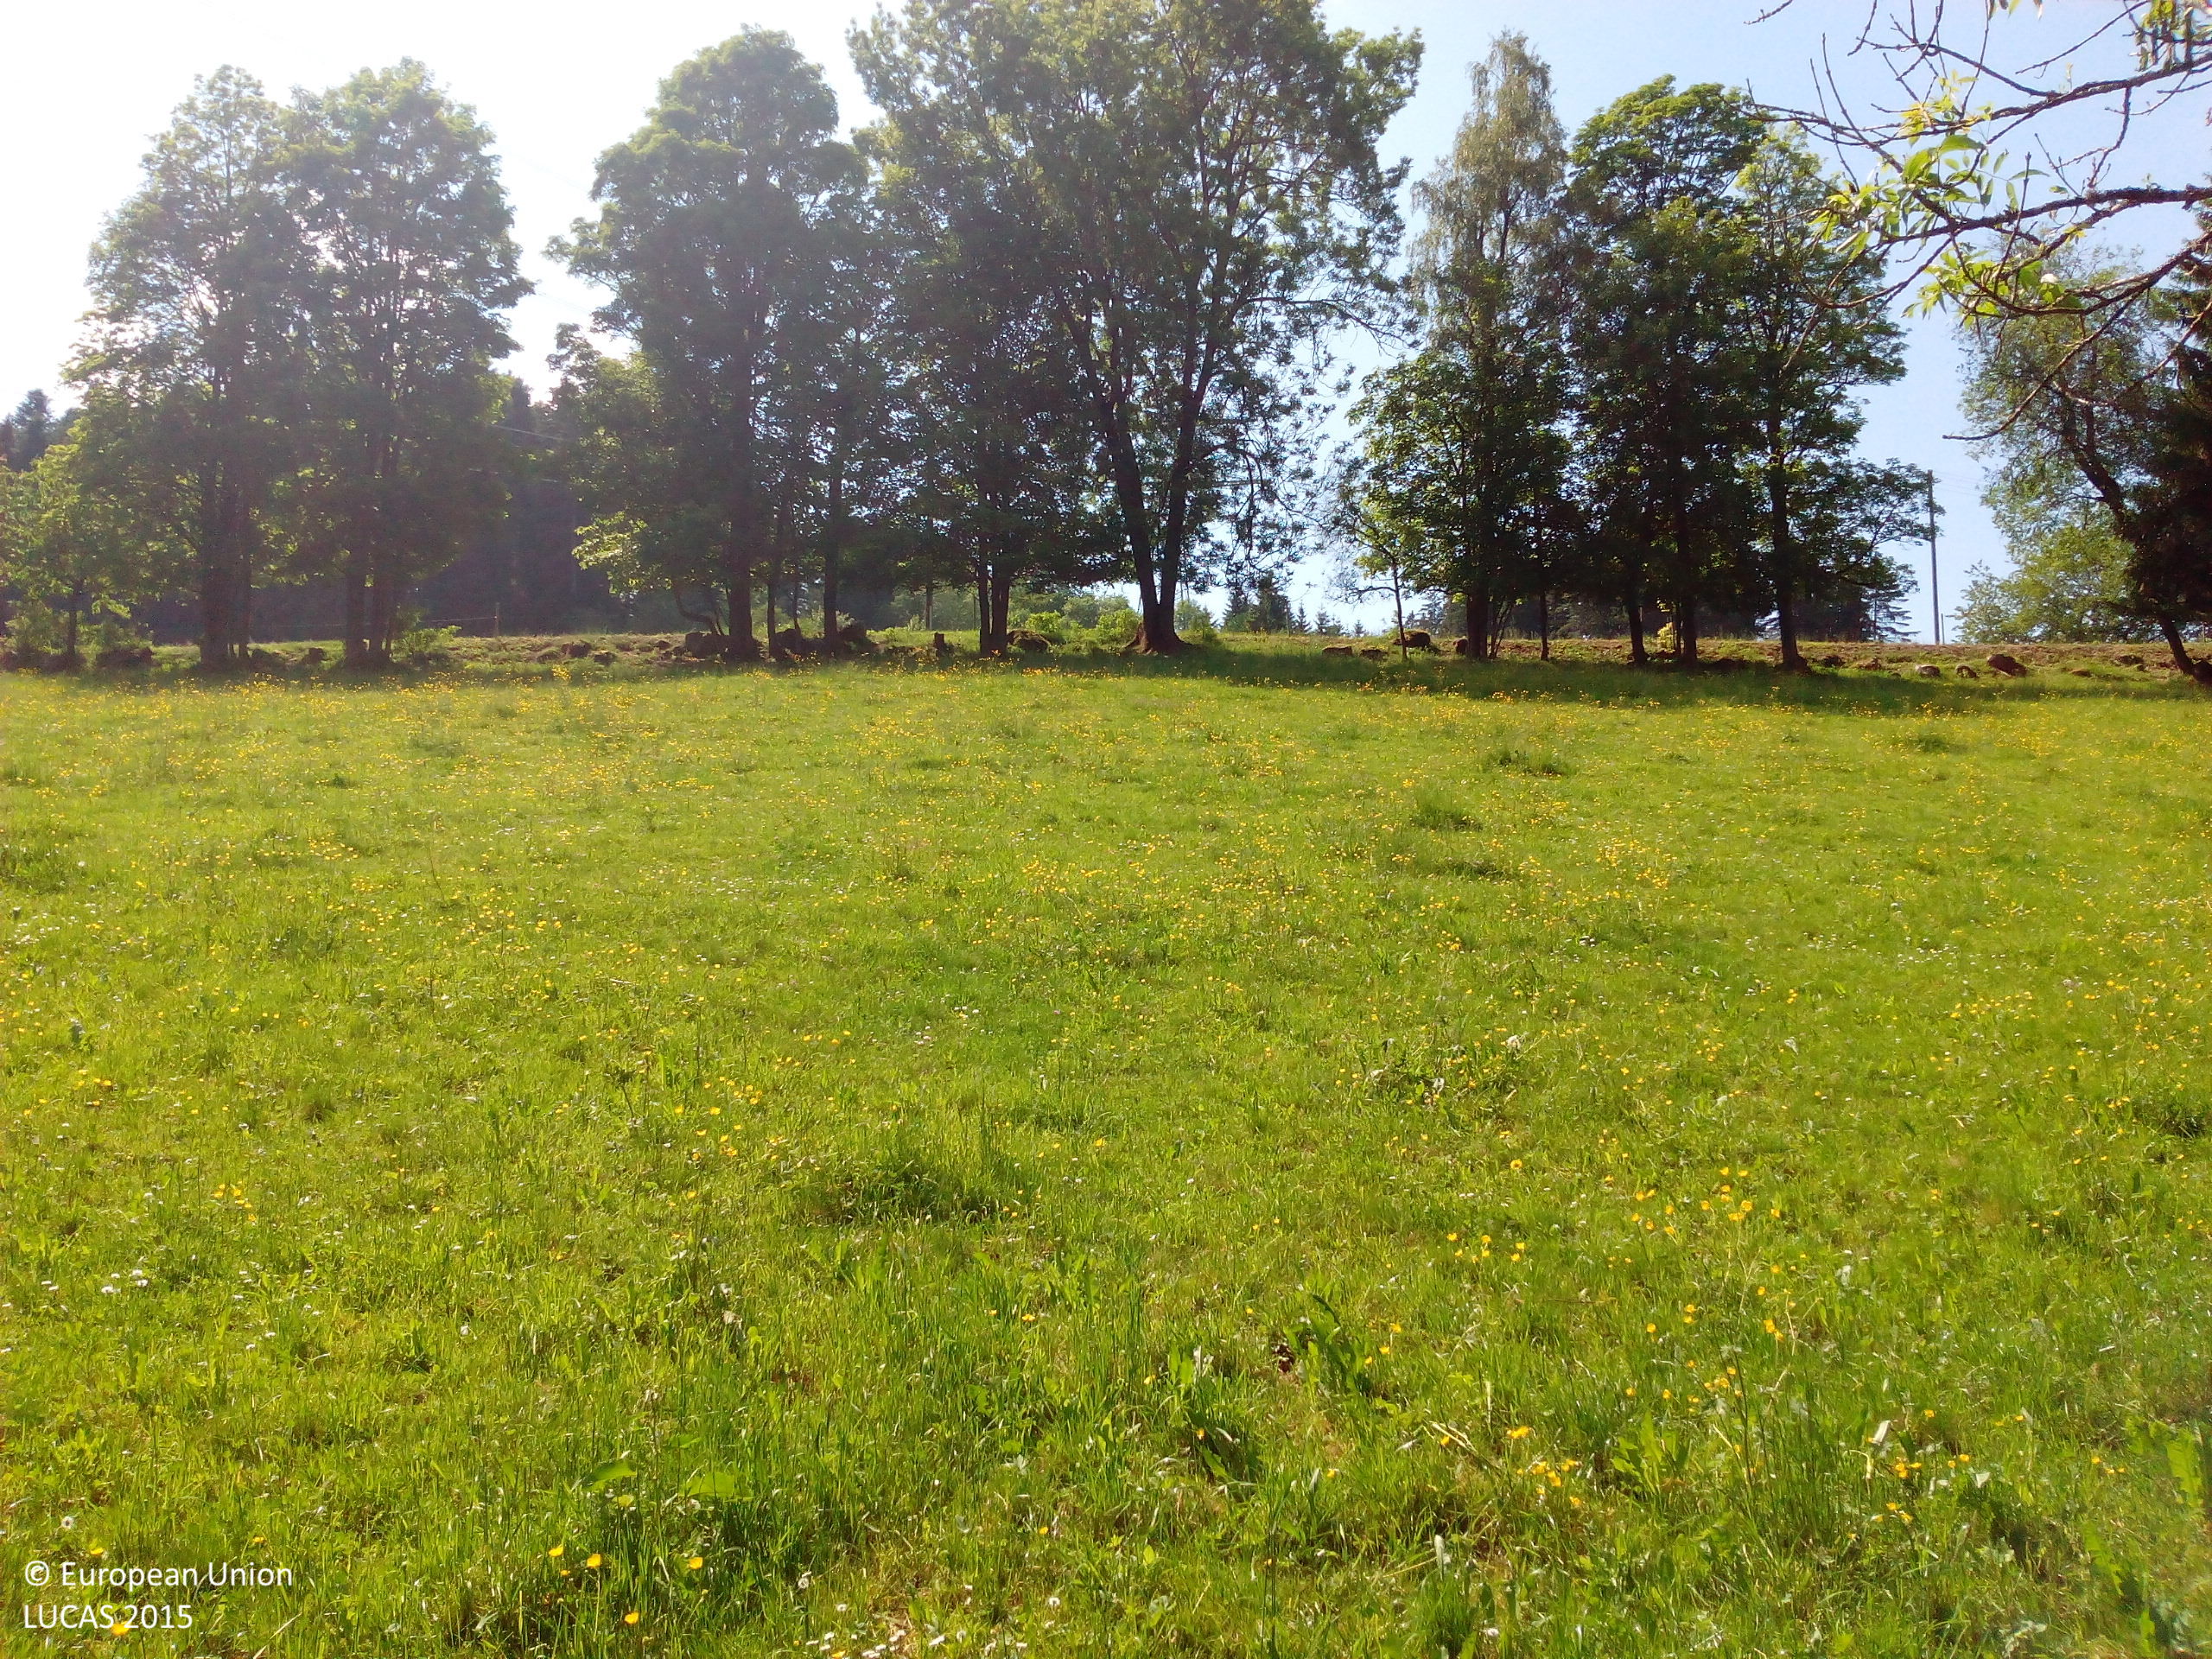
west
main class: Woodland
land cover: Broadleaved woodland
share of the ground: > 75 %
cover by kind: broadleaved forest trees 80 %, shrubs 10 %, herbaceous plants 10 %
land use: Forestry
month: June
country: DE
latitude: 47.9194
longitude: 8.1143
